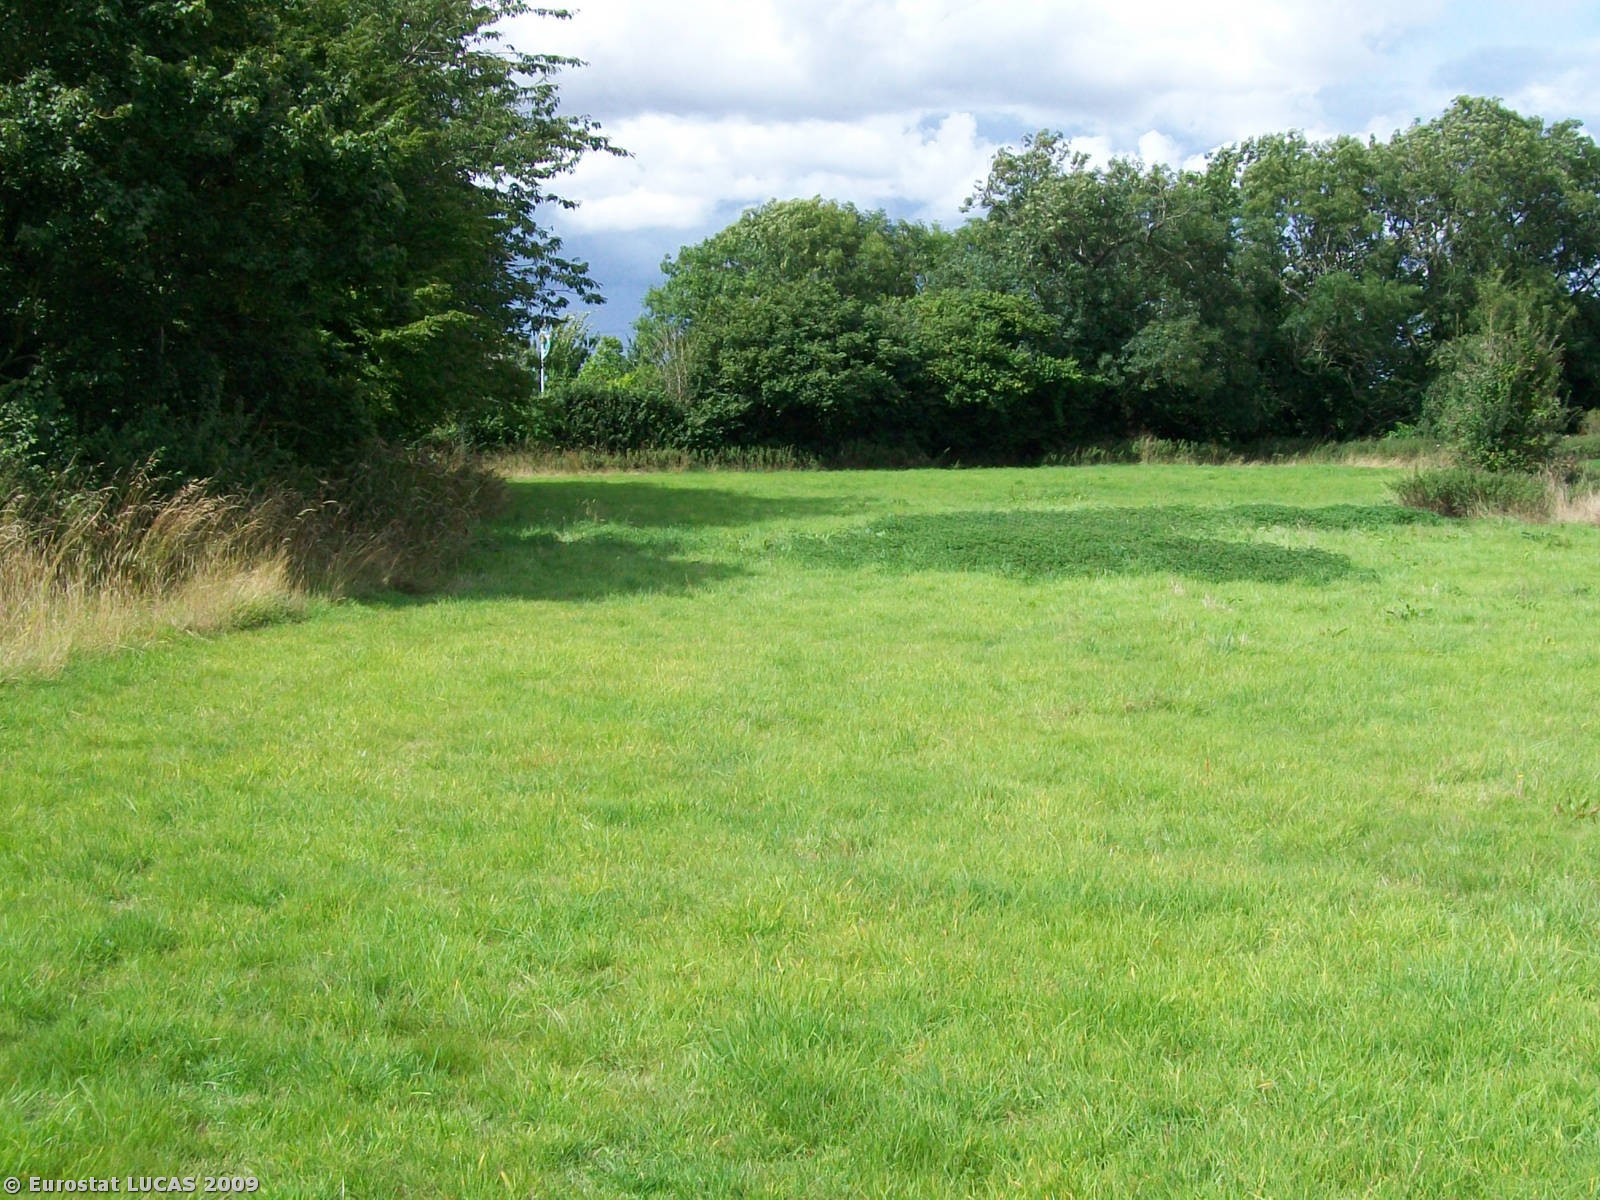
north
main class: Grassland
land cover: Grassland without tree/shrub cover
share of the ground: > 75 %
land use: Agriculture (excluding fallow land and kitchen gardens)
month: July
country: GB
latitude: 51.5020
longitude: -2.2646
